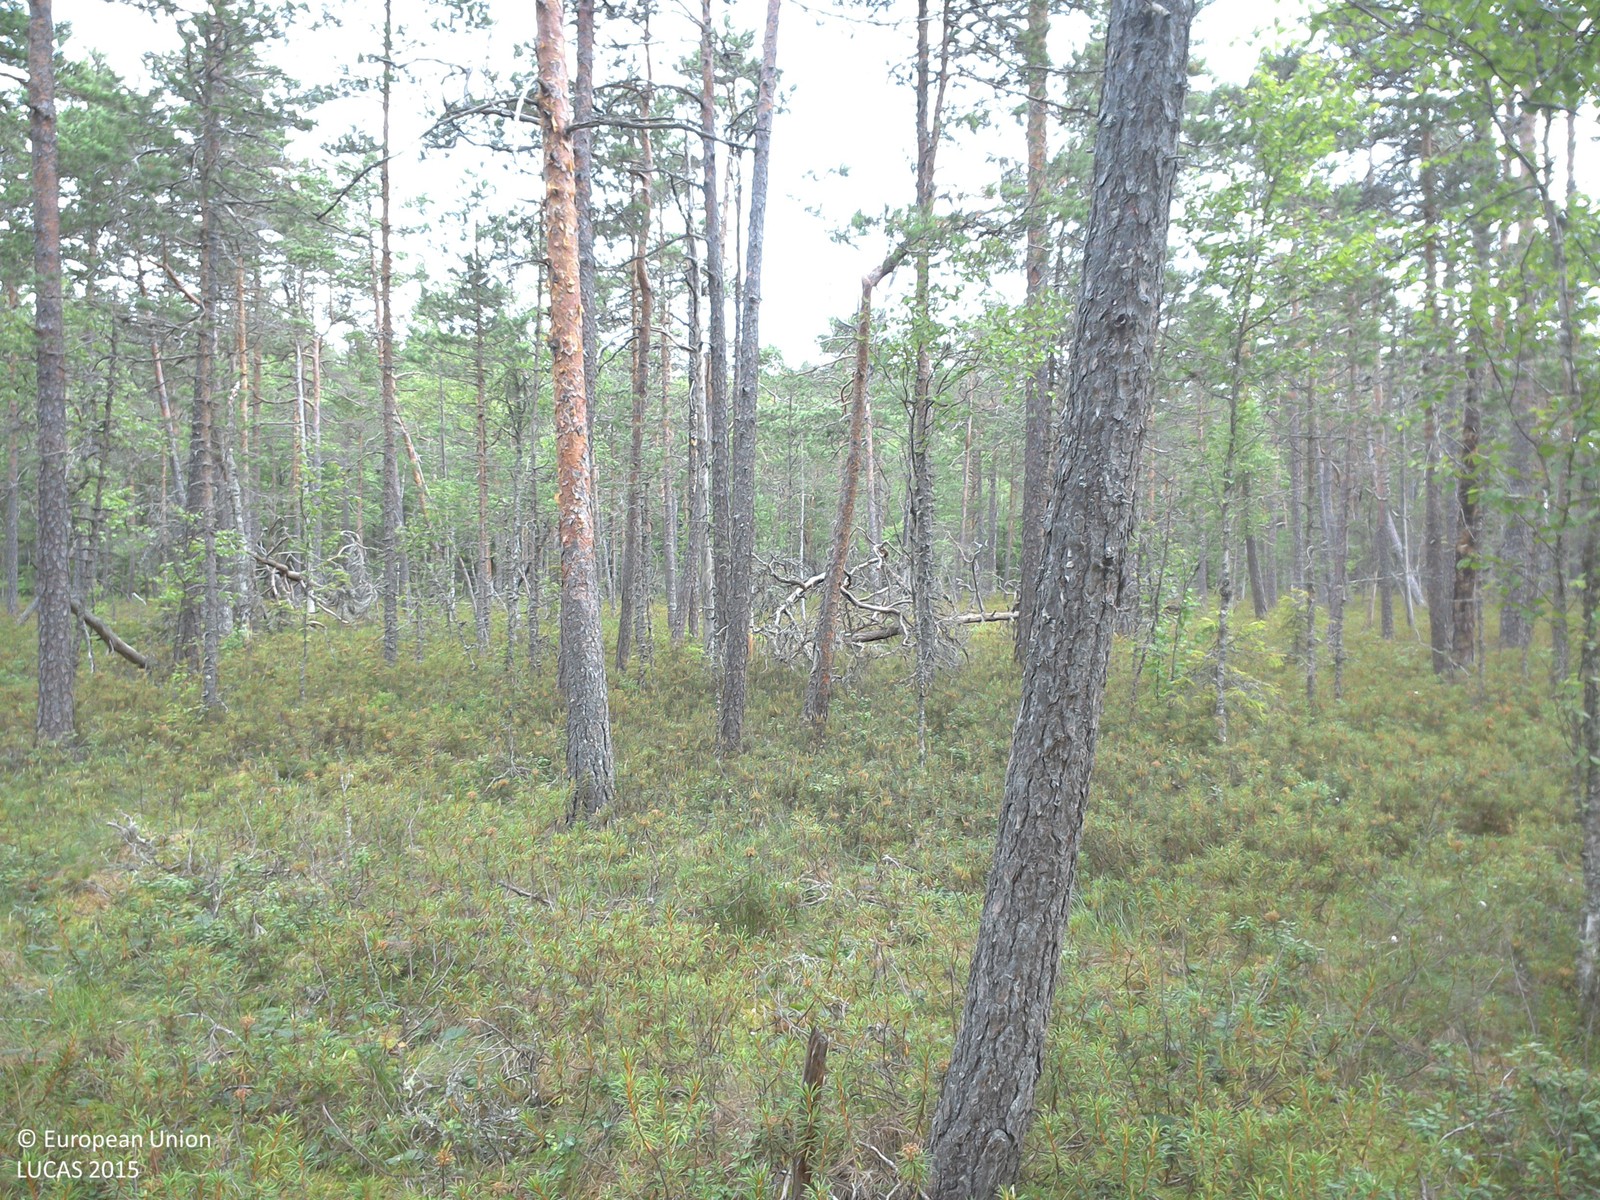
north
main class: Woodland
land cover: Pine dominated coniferous woodland
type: boreal forest
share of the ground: 25 - 50 %
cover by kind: herbaceous plants 40 %, coniferous forest trees 30 %, lichens and mosses 30 %
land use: Forestry
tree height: > 5 m
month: July
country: SE
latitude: 57.8520
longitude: 15.9785
